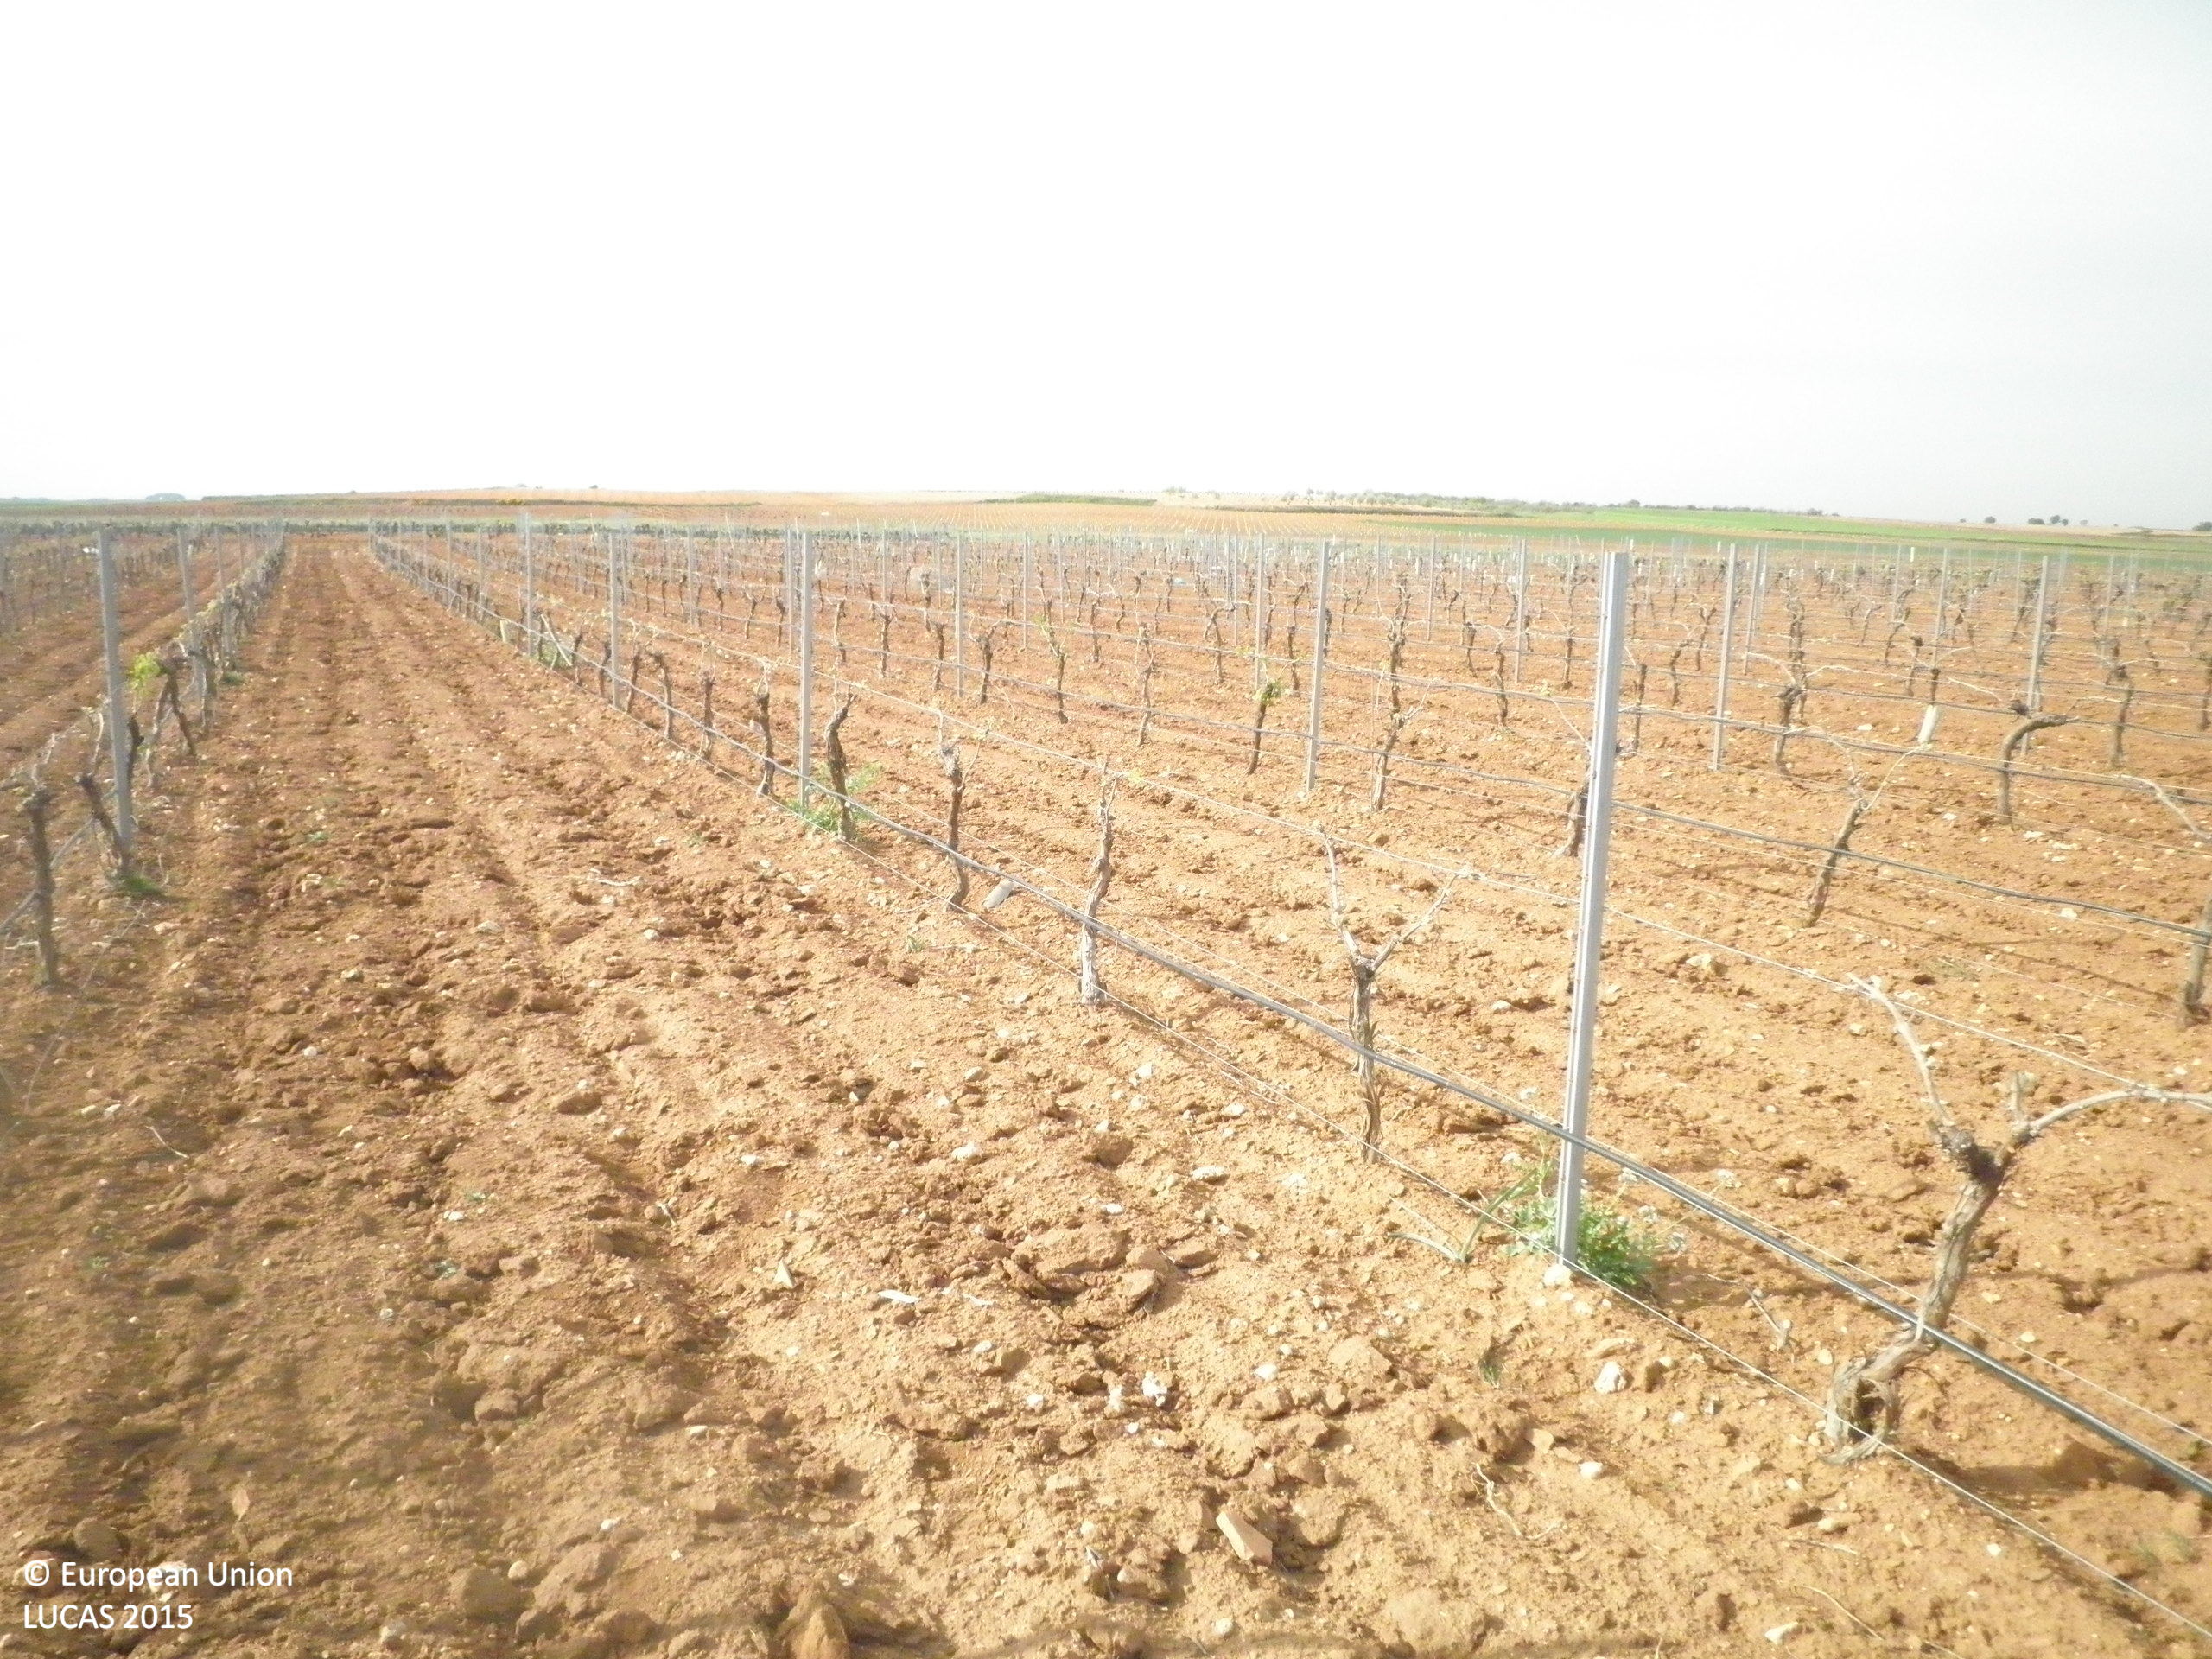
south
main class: Cropland
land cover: Vineyards
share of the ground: < 10 %
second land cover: Other bare soil
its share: > 75 %
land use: Agriculture (excluding fallow land and kitchen gardens)
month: April
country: ES
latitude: 39.3742
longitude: -2.7703
